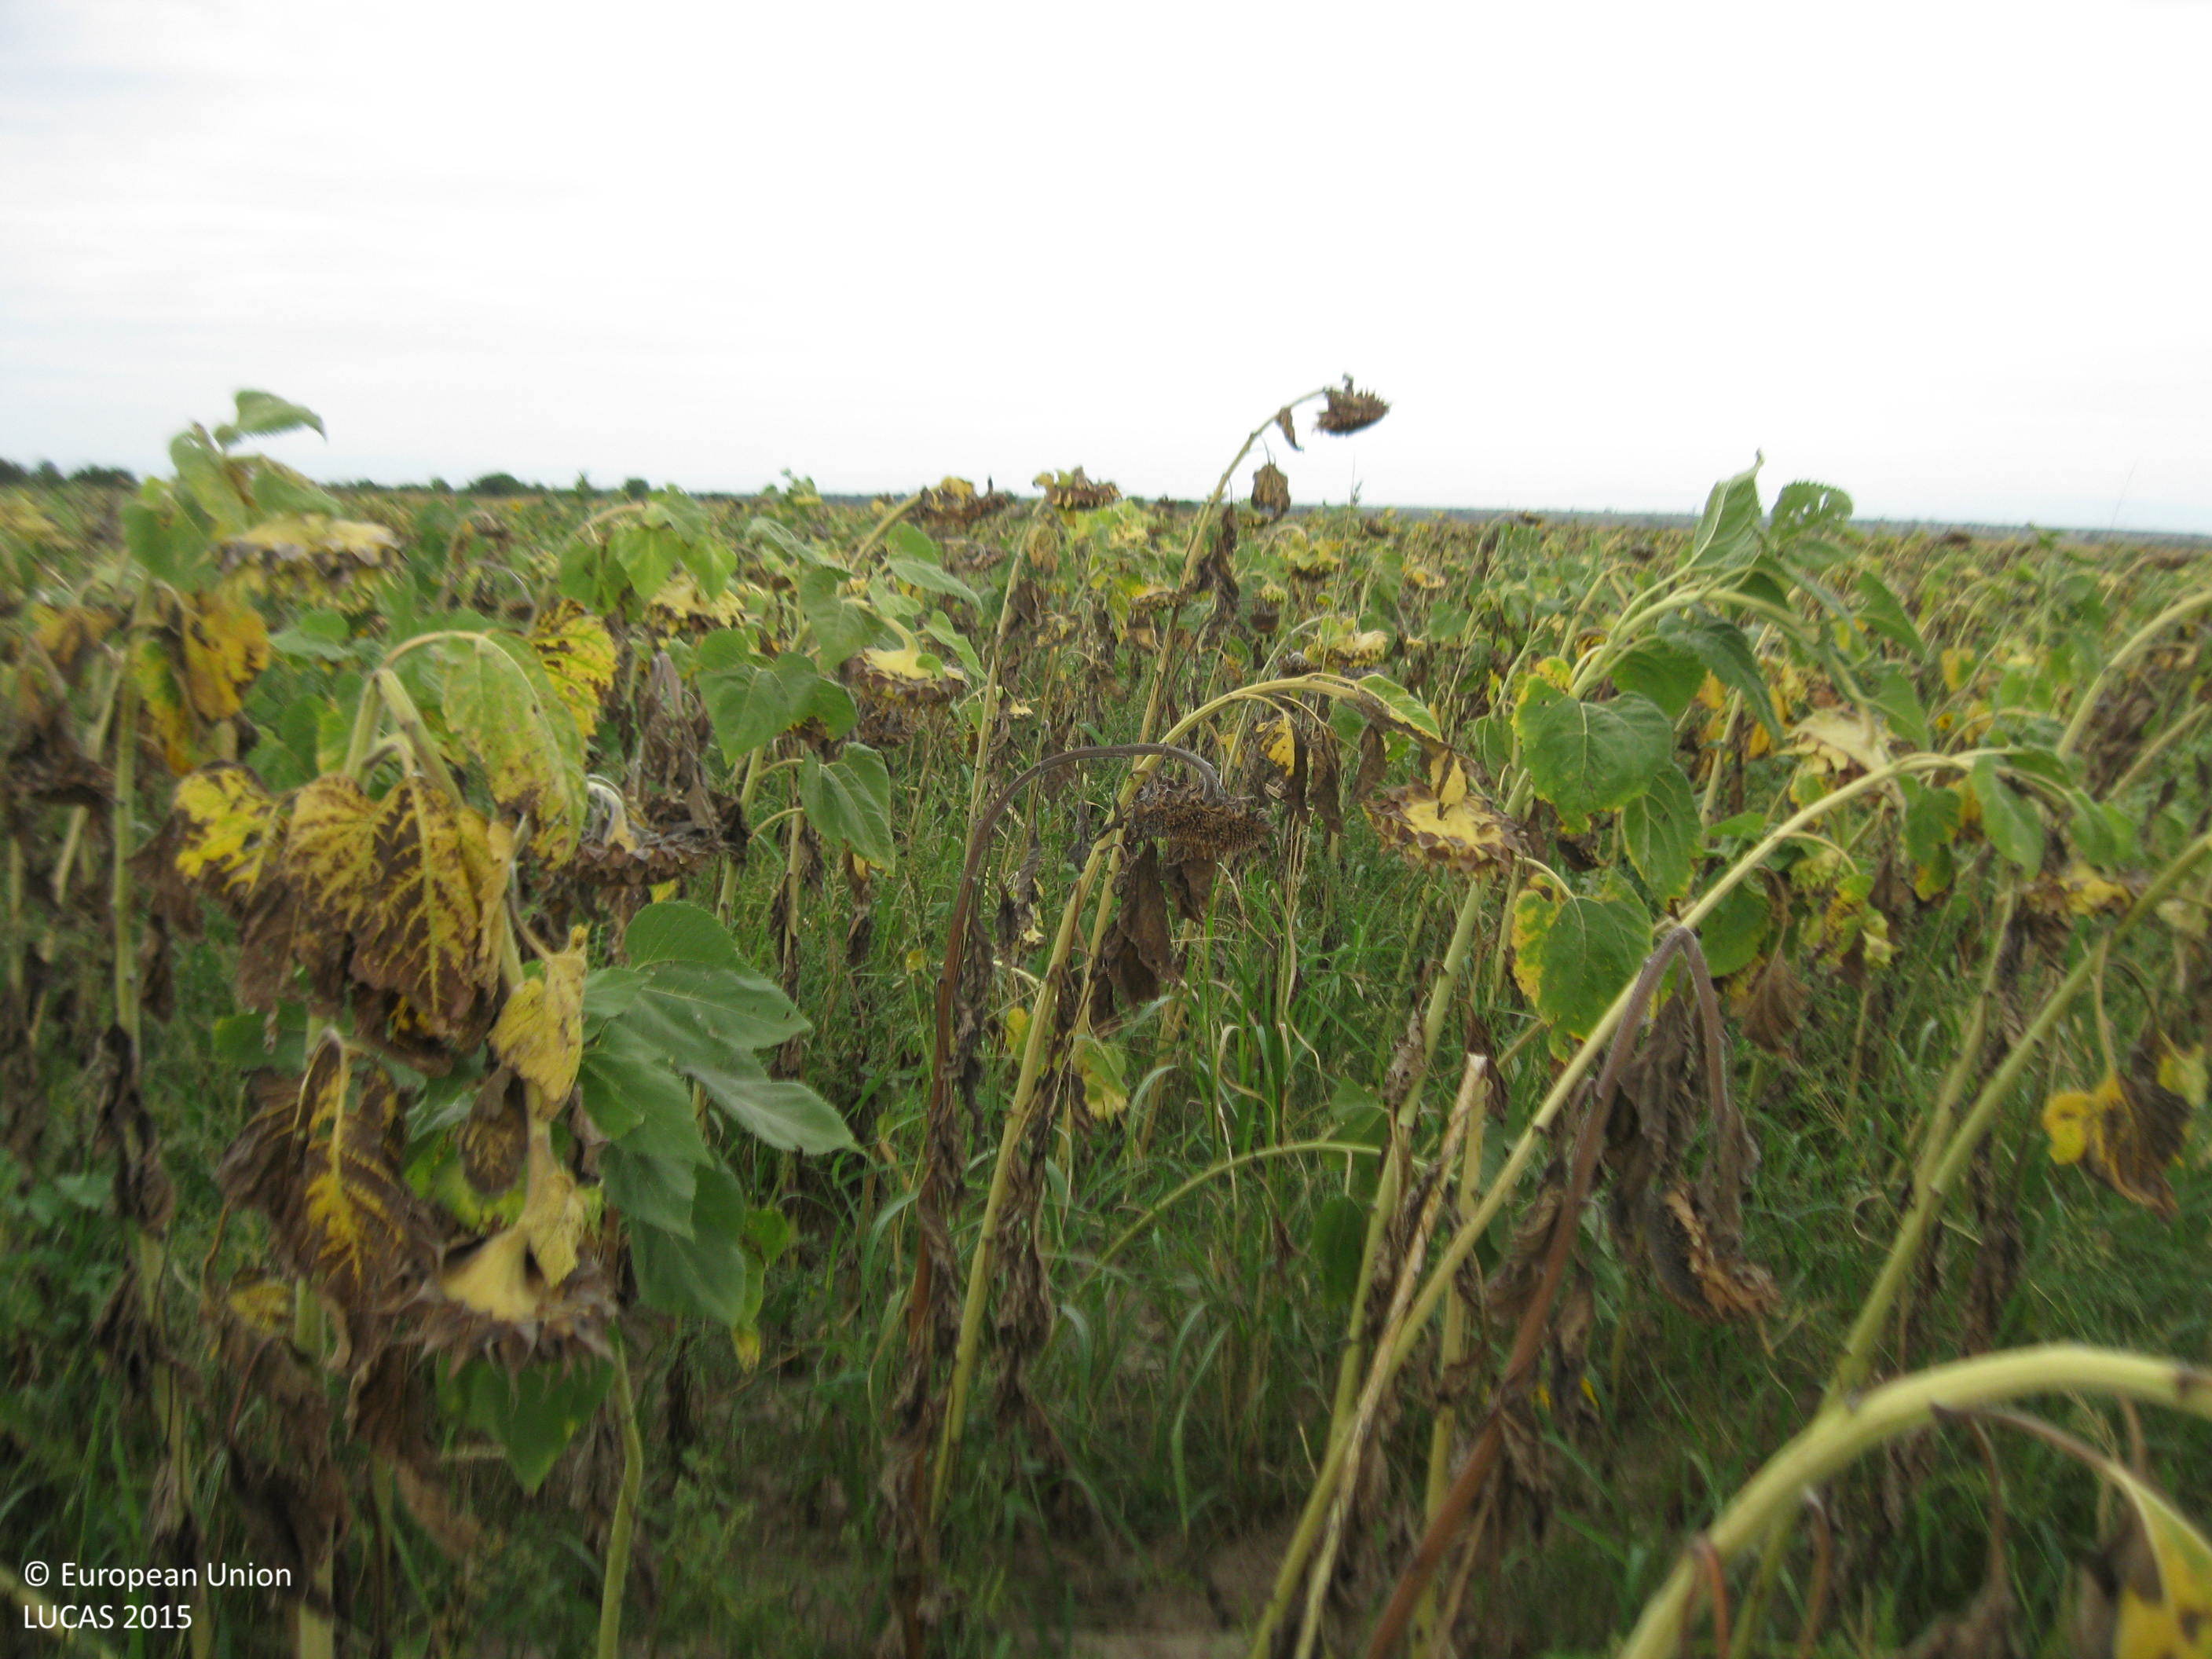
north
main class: Cropland
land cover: Sunflower
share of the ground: 50 - 75 %
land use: Agriculture (excluding fallow land and kitchen gardens)
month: September
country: BG
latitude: 42.0610
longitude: 25.0034
